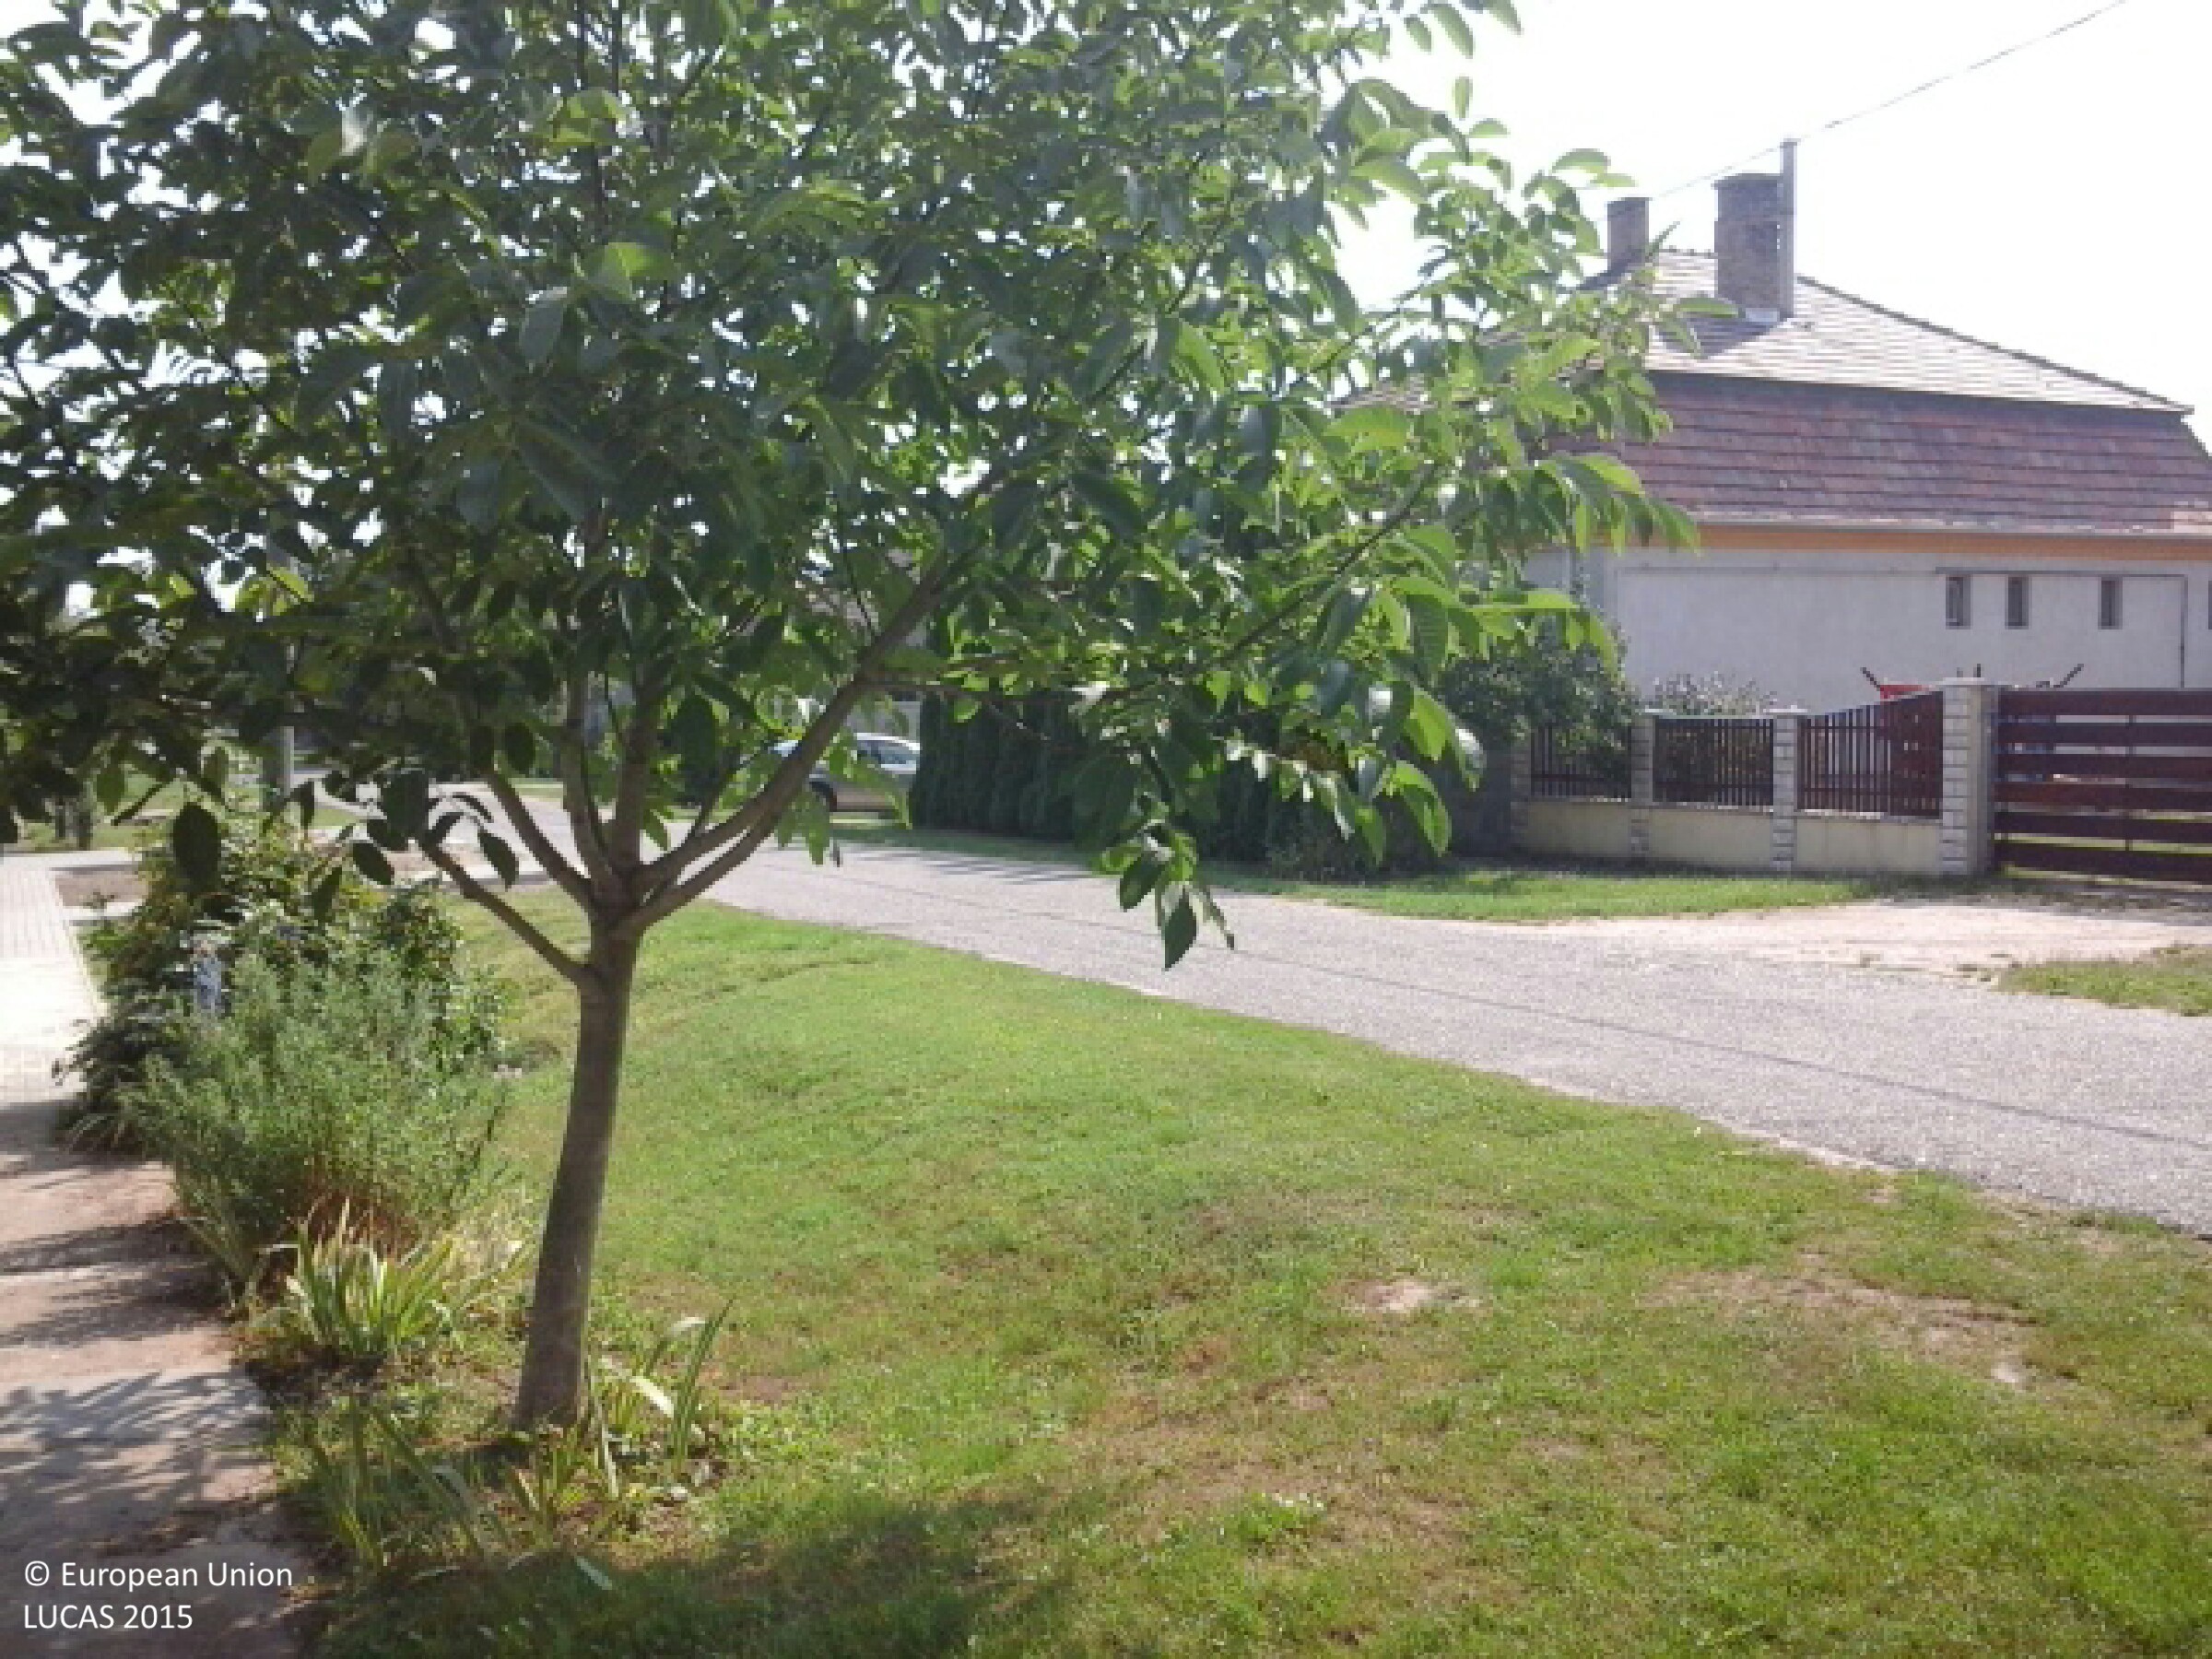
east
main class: Grassland
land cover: Grassland without tree/shrub cover
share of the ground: > 75 %
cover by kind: herbaceous plants 95 %, shrubs 5 %
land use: Residential
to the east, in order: Grassland without tree/shrub cover; Artificial constructions in urban areas
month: August
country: HU
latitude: 47.6663
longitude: 18.1758
